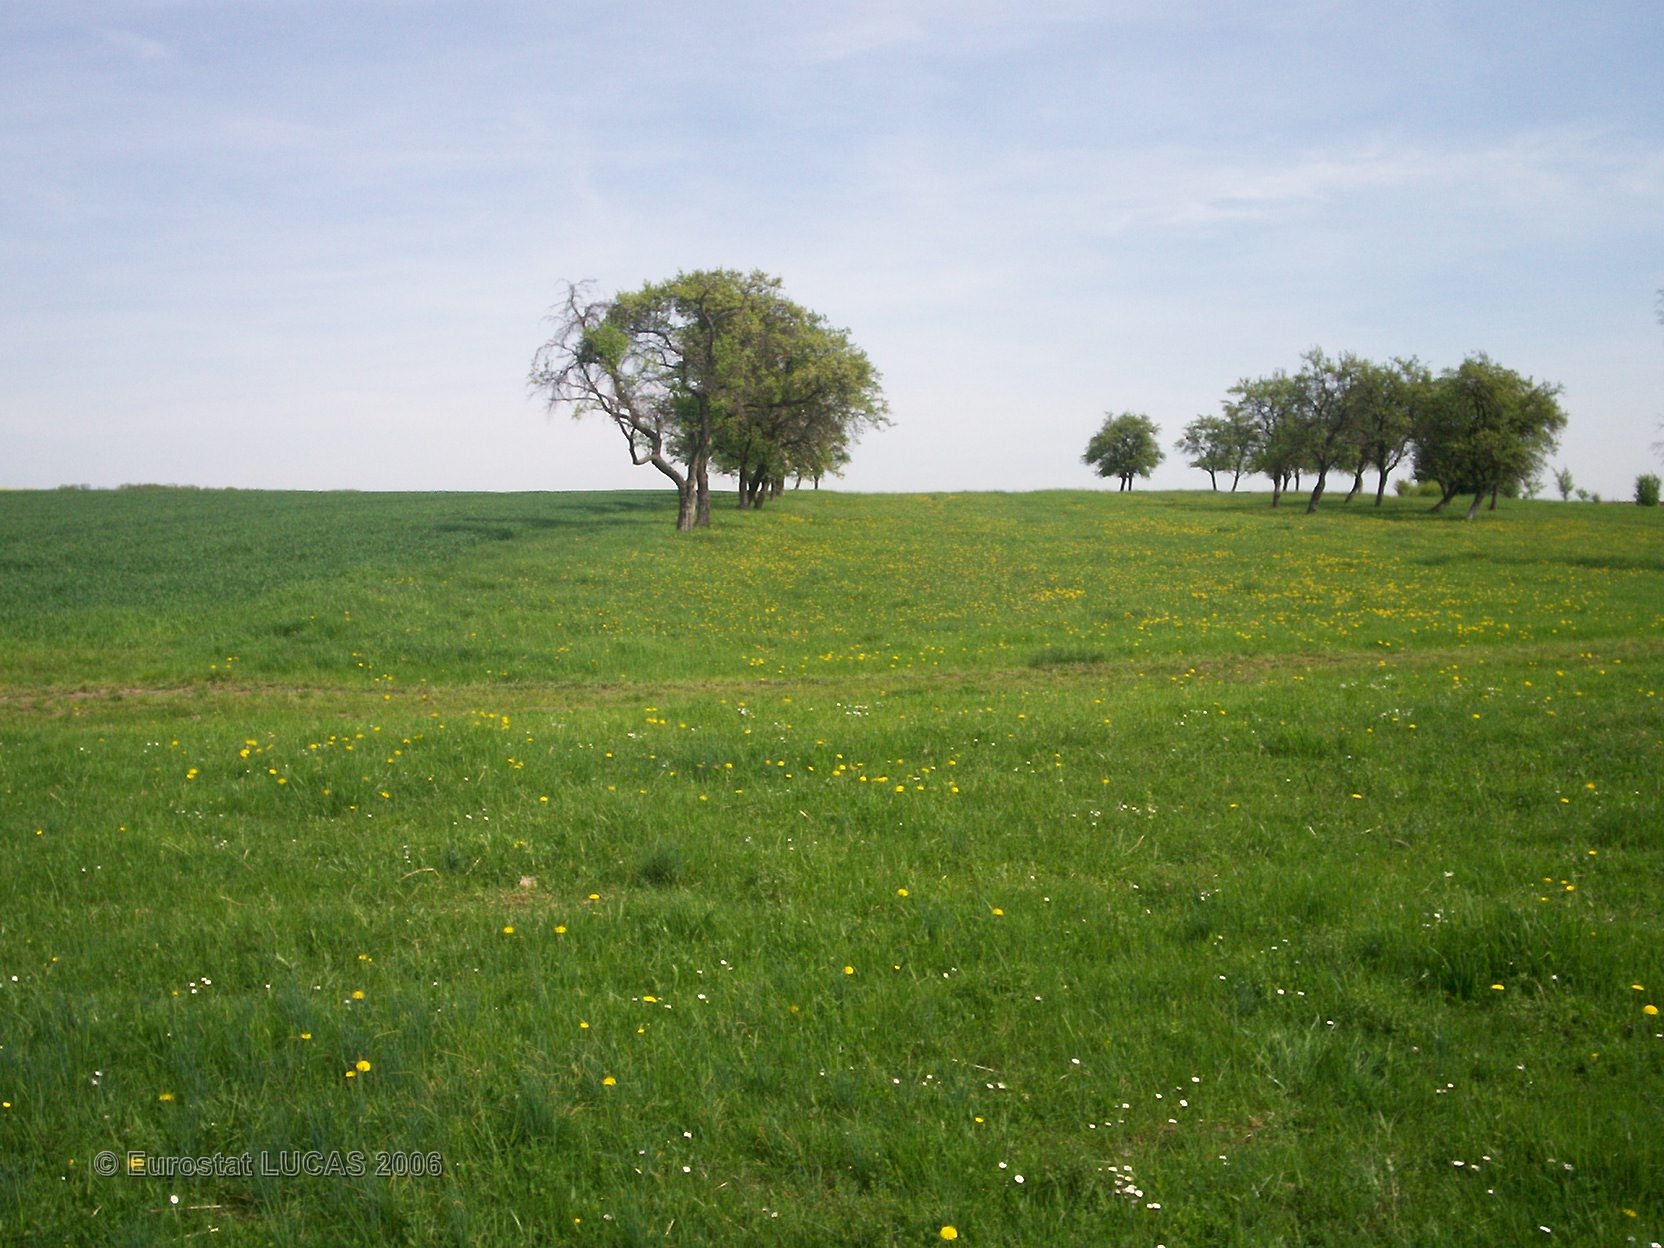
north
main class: Grassland
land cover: Grassland without tree/shrub cover
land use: Agriculture (excluding fallow land and kitchen gardens)
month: May
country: FR
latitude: 48.9565
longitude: 6.9823
